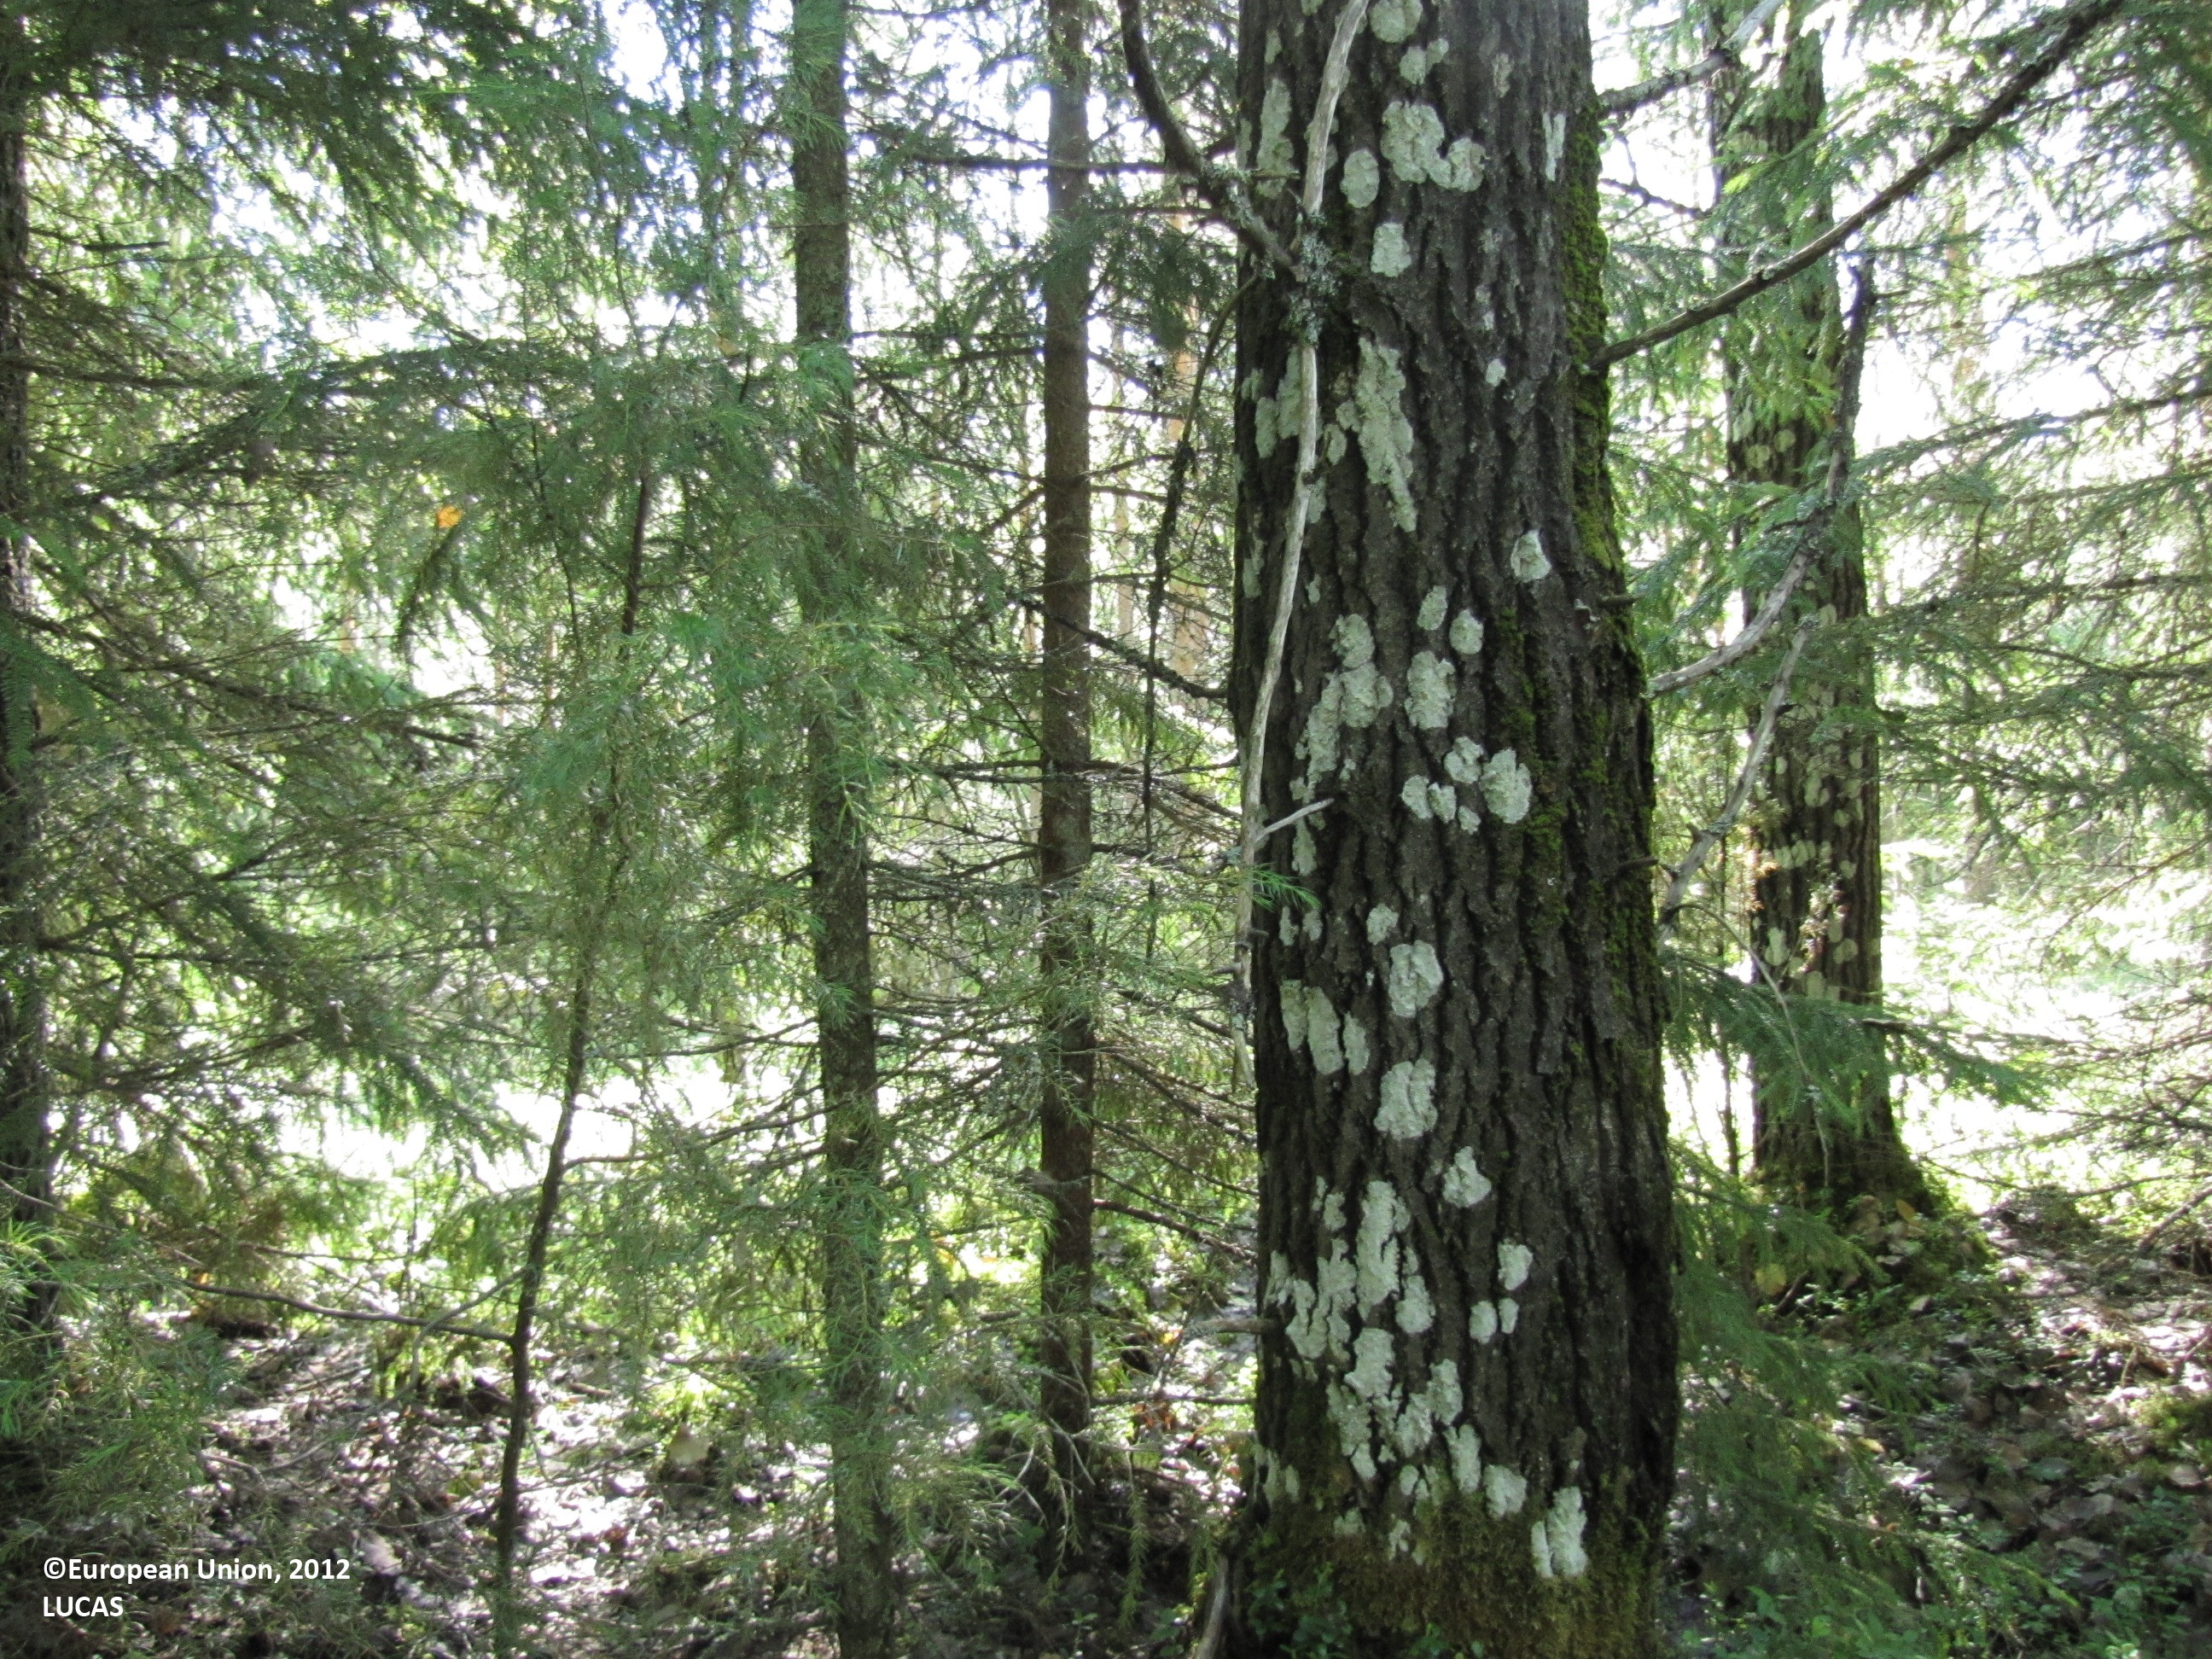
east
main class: Woodland
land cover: Other mixed woodland
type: boreal forest
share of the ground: > 75 %
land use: Forestry
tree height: > 5 m
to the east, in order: Other mixed woodland; Pine dominated mixed woodland; Ditches and canals; Other mixed woodland; Broadleaved woodland; Ditches and canals; Paved roads, cycling and walking lanes; Ditches and canals; Other mixed woodland; Broadleaved woodland; Ditches and canals; Spruce dominated mixed woodland
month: July
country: FI
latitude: 62.0910
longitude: 23.1099
